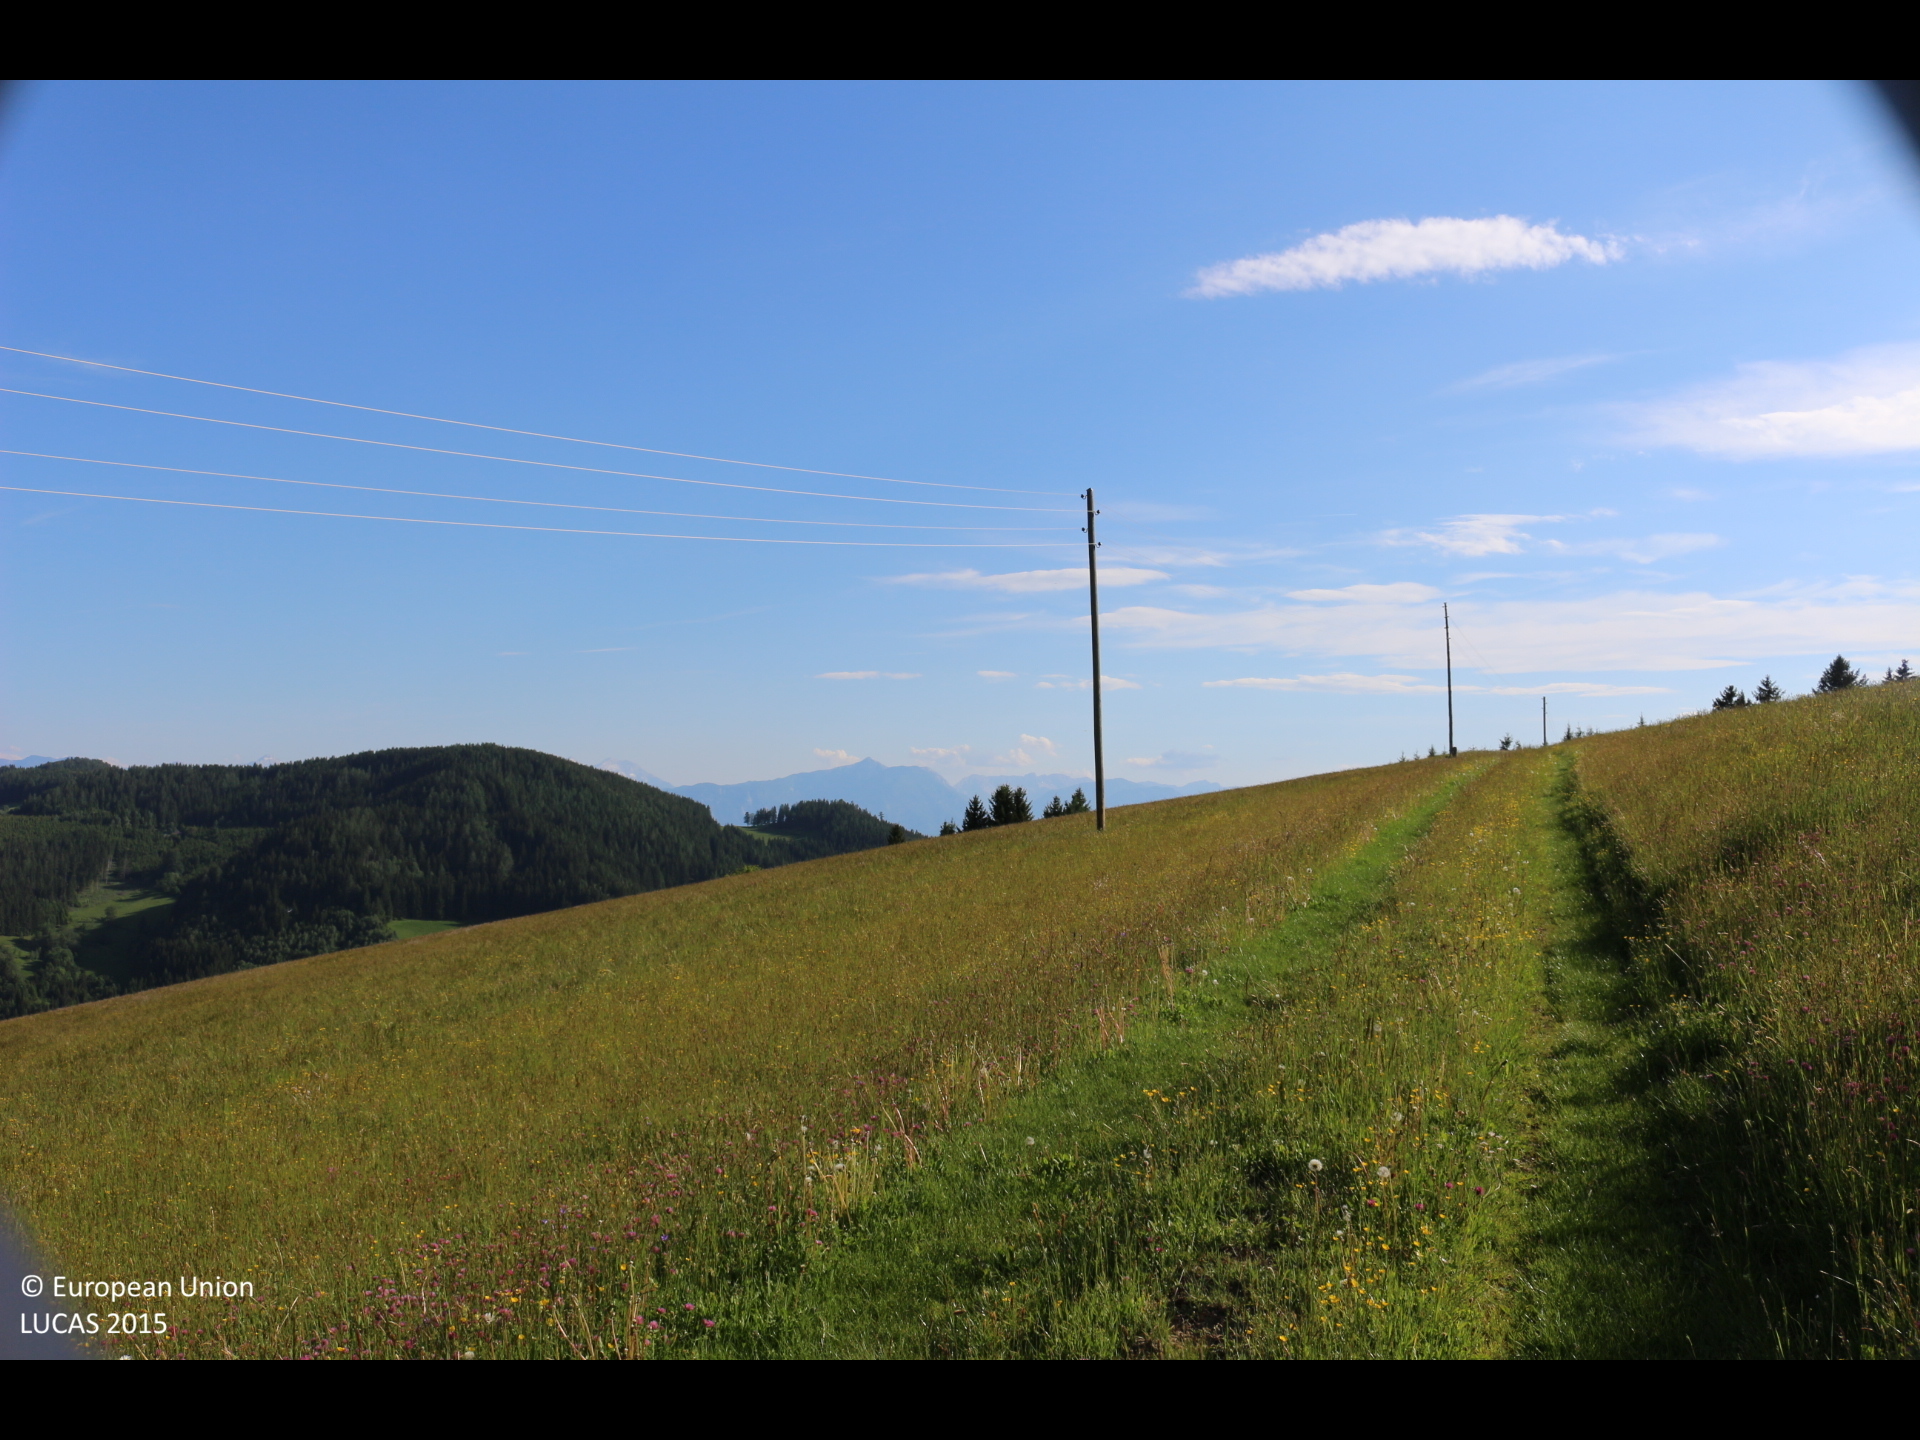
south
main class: Grassland
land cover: Grassland without tree/shrub cover
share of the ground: > 75 %
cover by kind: herbaceous plants 100 %
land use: Agriculture (excluding fallow land and kitchen gardens)
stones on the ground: < 10 %
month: May
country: AT
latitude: 46.7576
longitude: 14.5933
